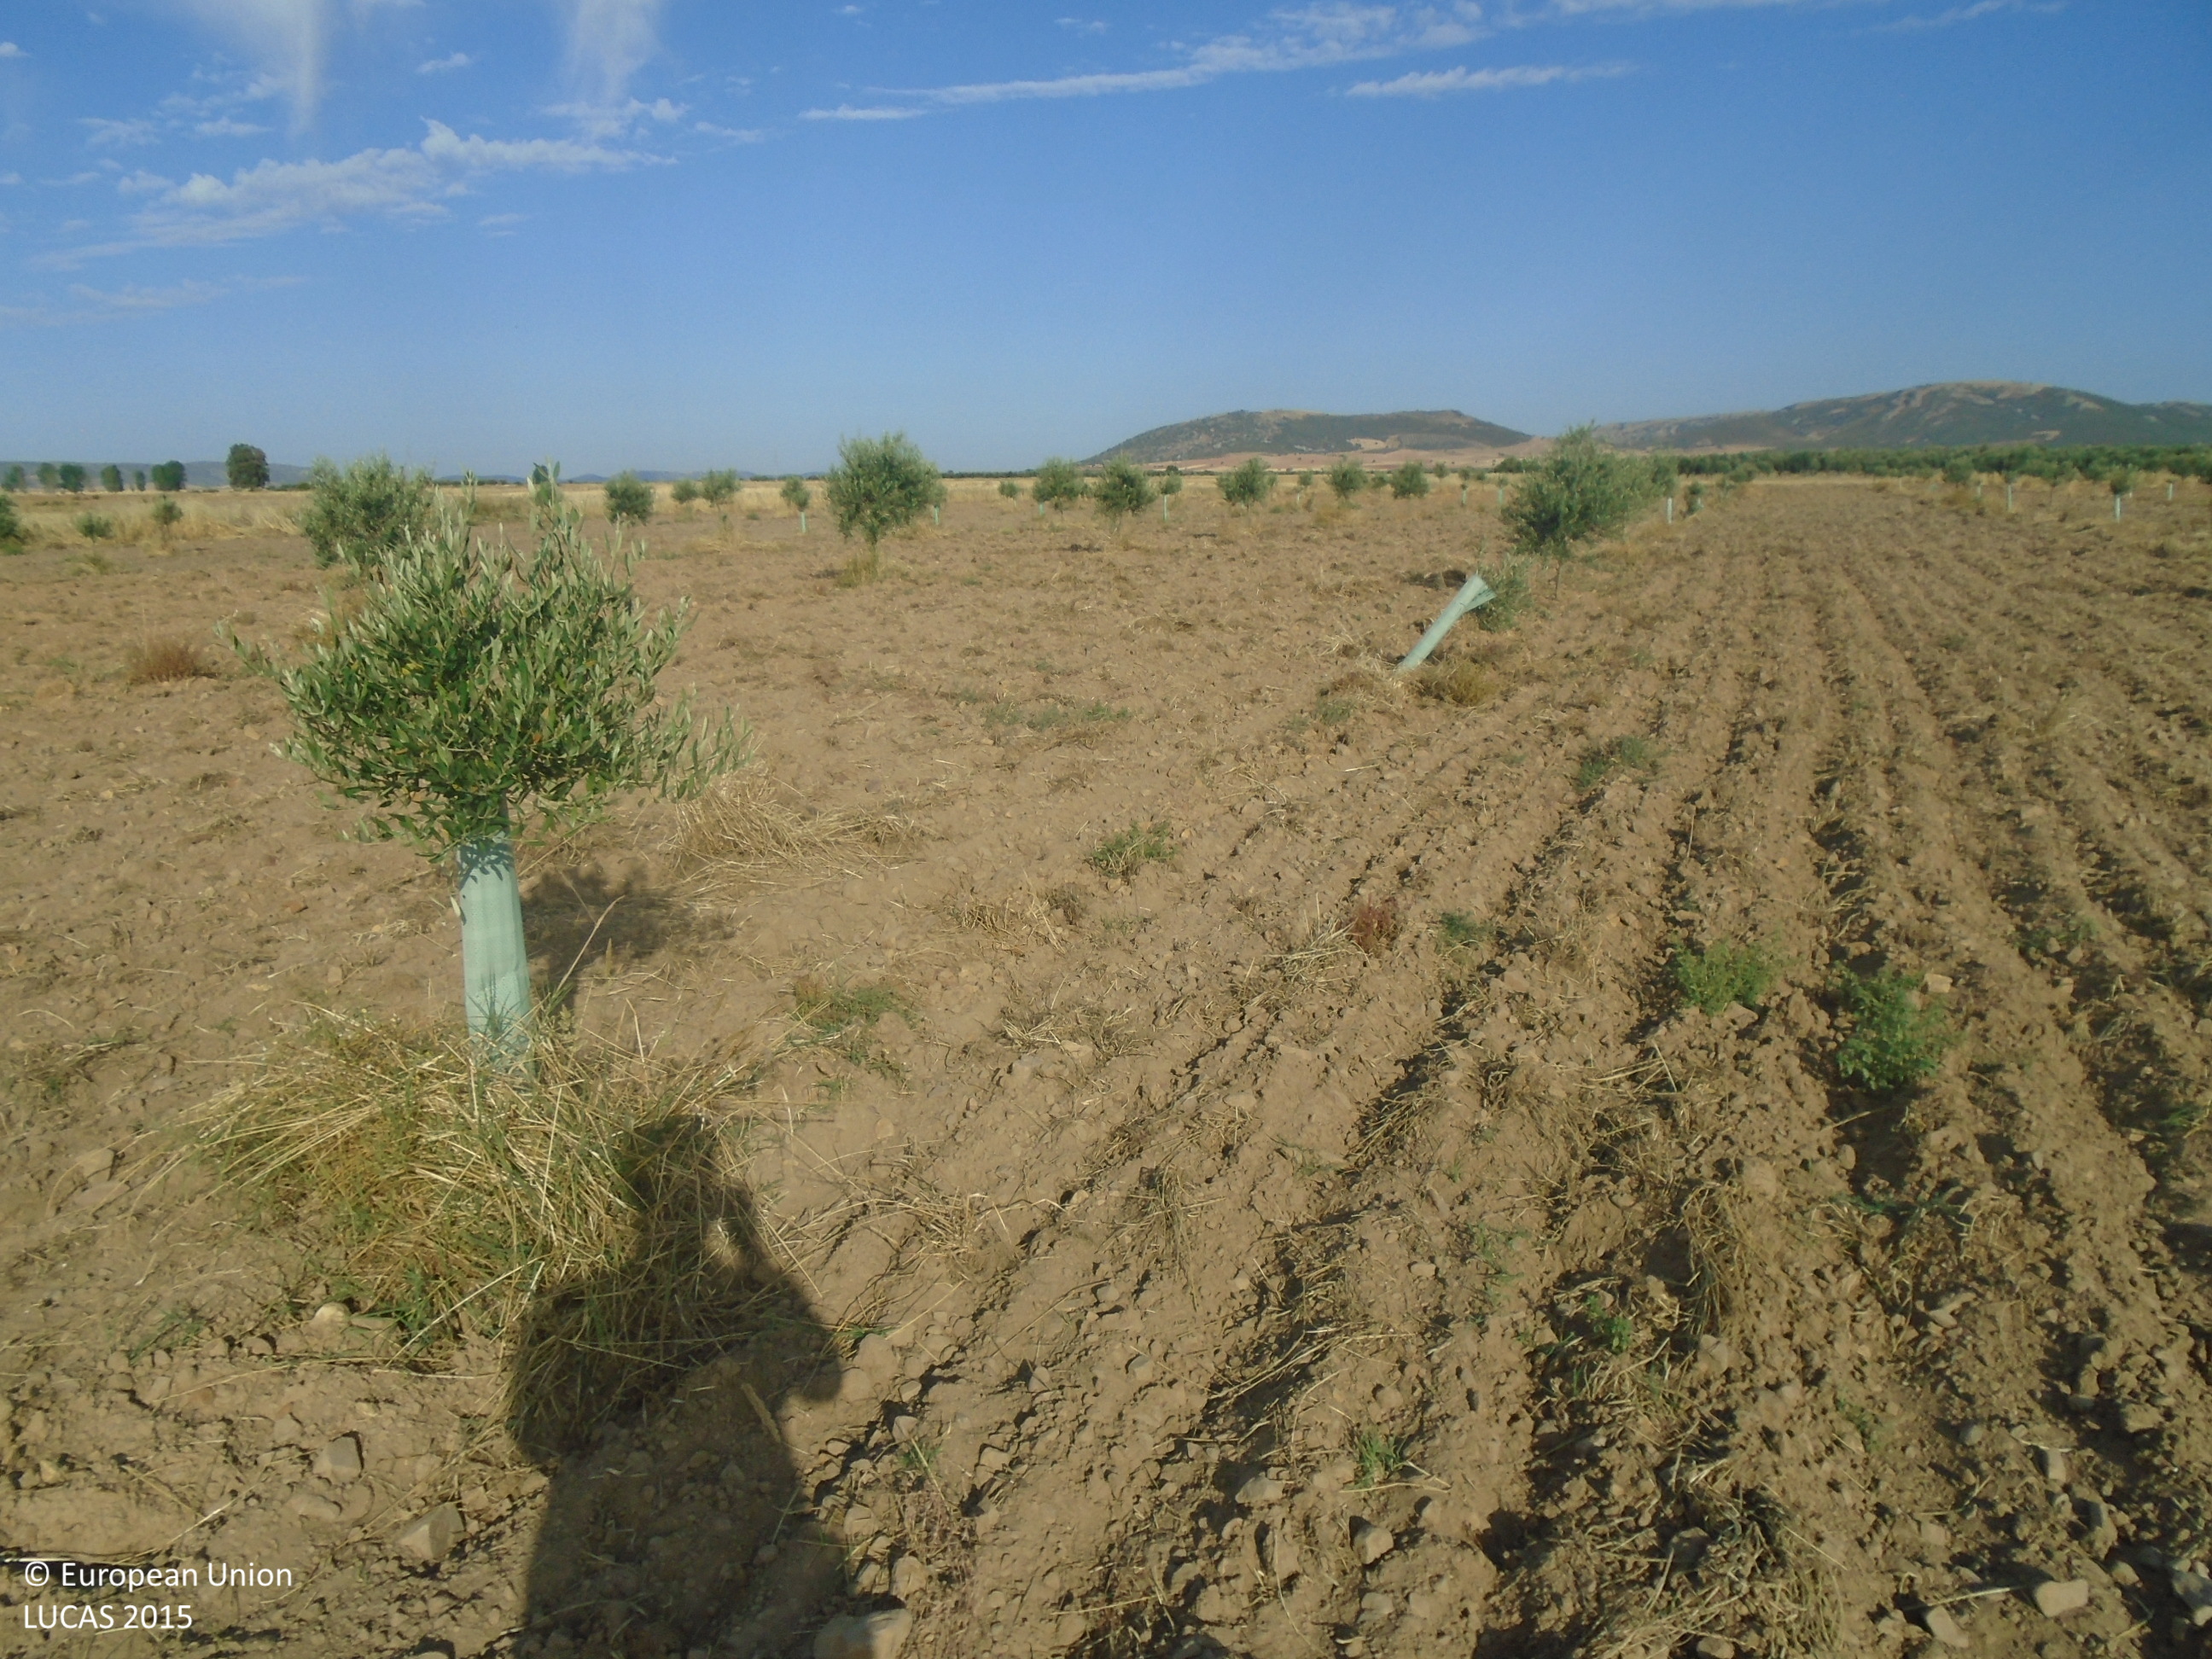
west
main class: Cropland
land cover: Olive groves
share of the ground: < 10 %
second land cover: Other bare soil
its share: > 75 %
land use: Agriculture (excluding fallow land and kitchen gardens)
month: July
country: ES
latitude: 39.1784
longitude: -4.0431
